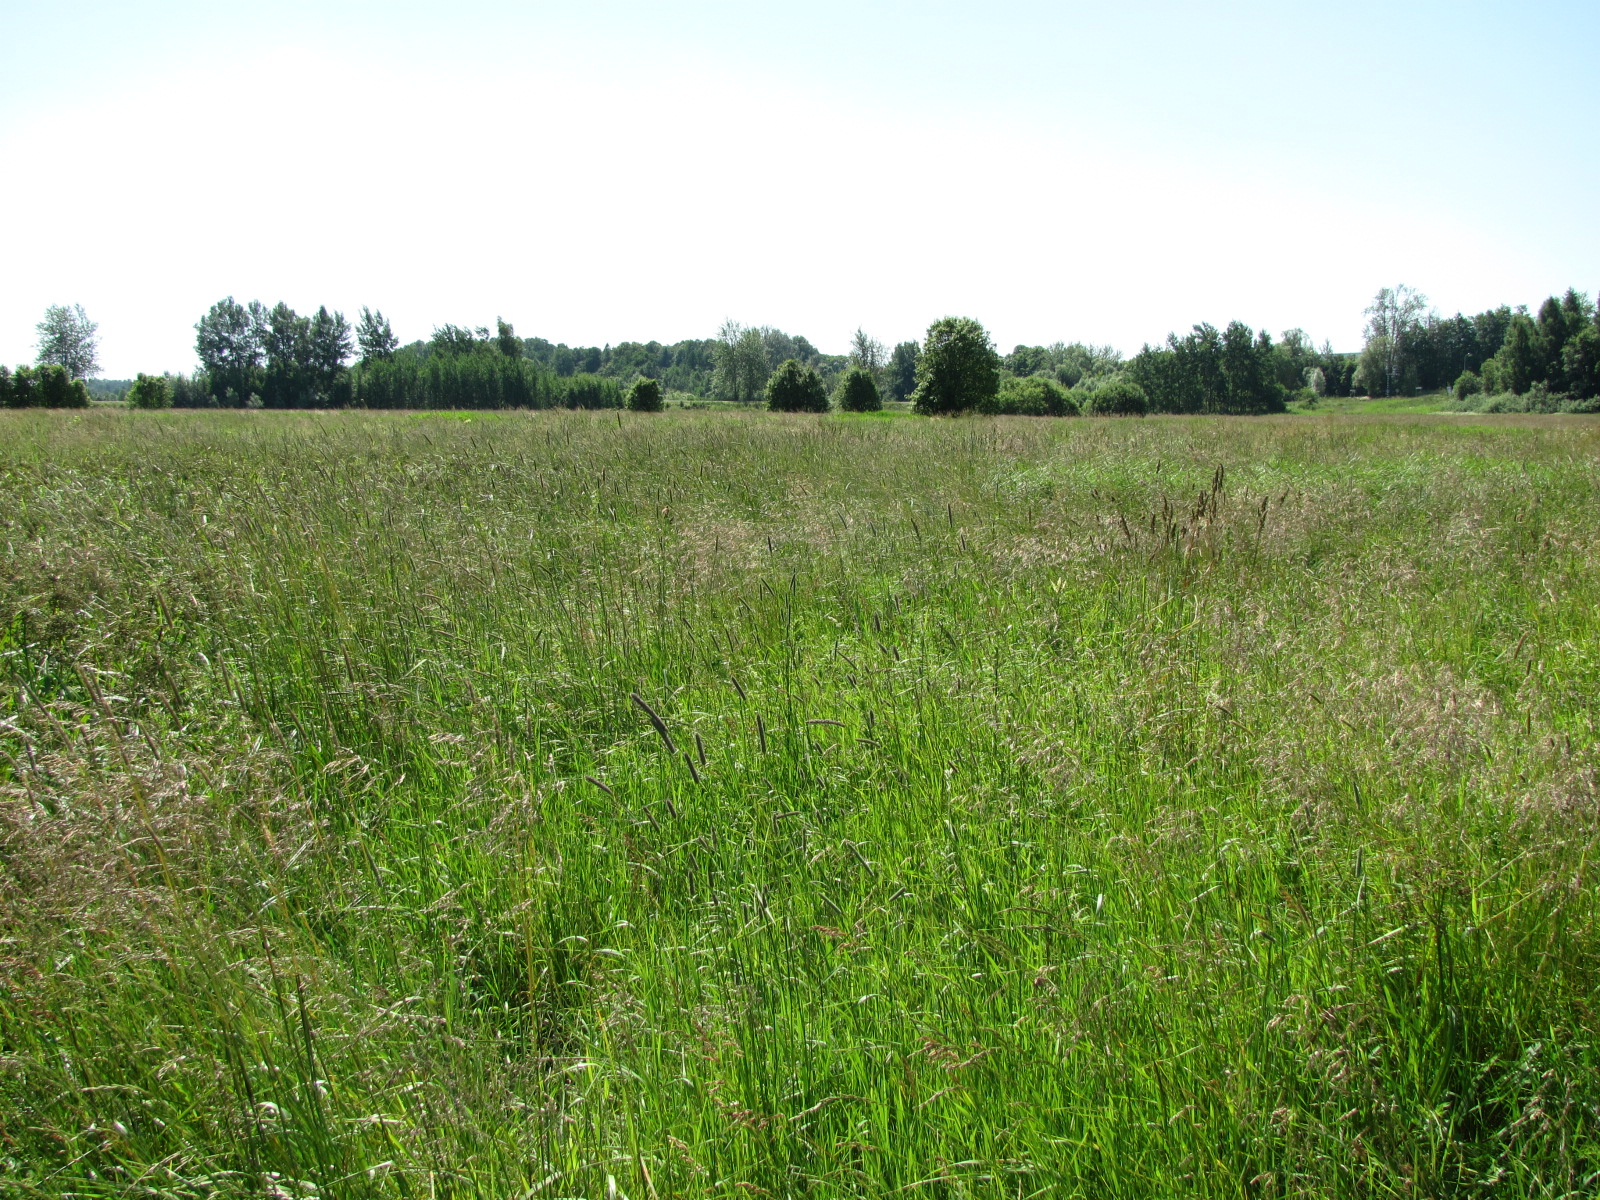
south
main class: Grassland
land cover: Grassland without tree/shrub cover
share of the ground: > 75 %
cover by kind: herbaceous plants 100 %
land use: Agriculture (excluding fallow land and kitchen gardens)
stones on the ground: < 10 %
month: July
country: LV
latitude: 56.8974
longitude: 24.1564
